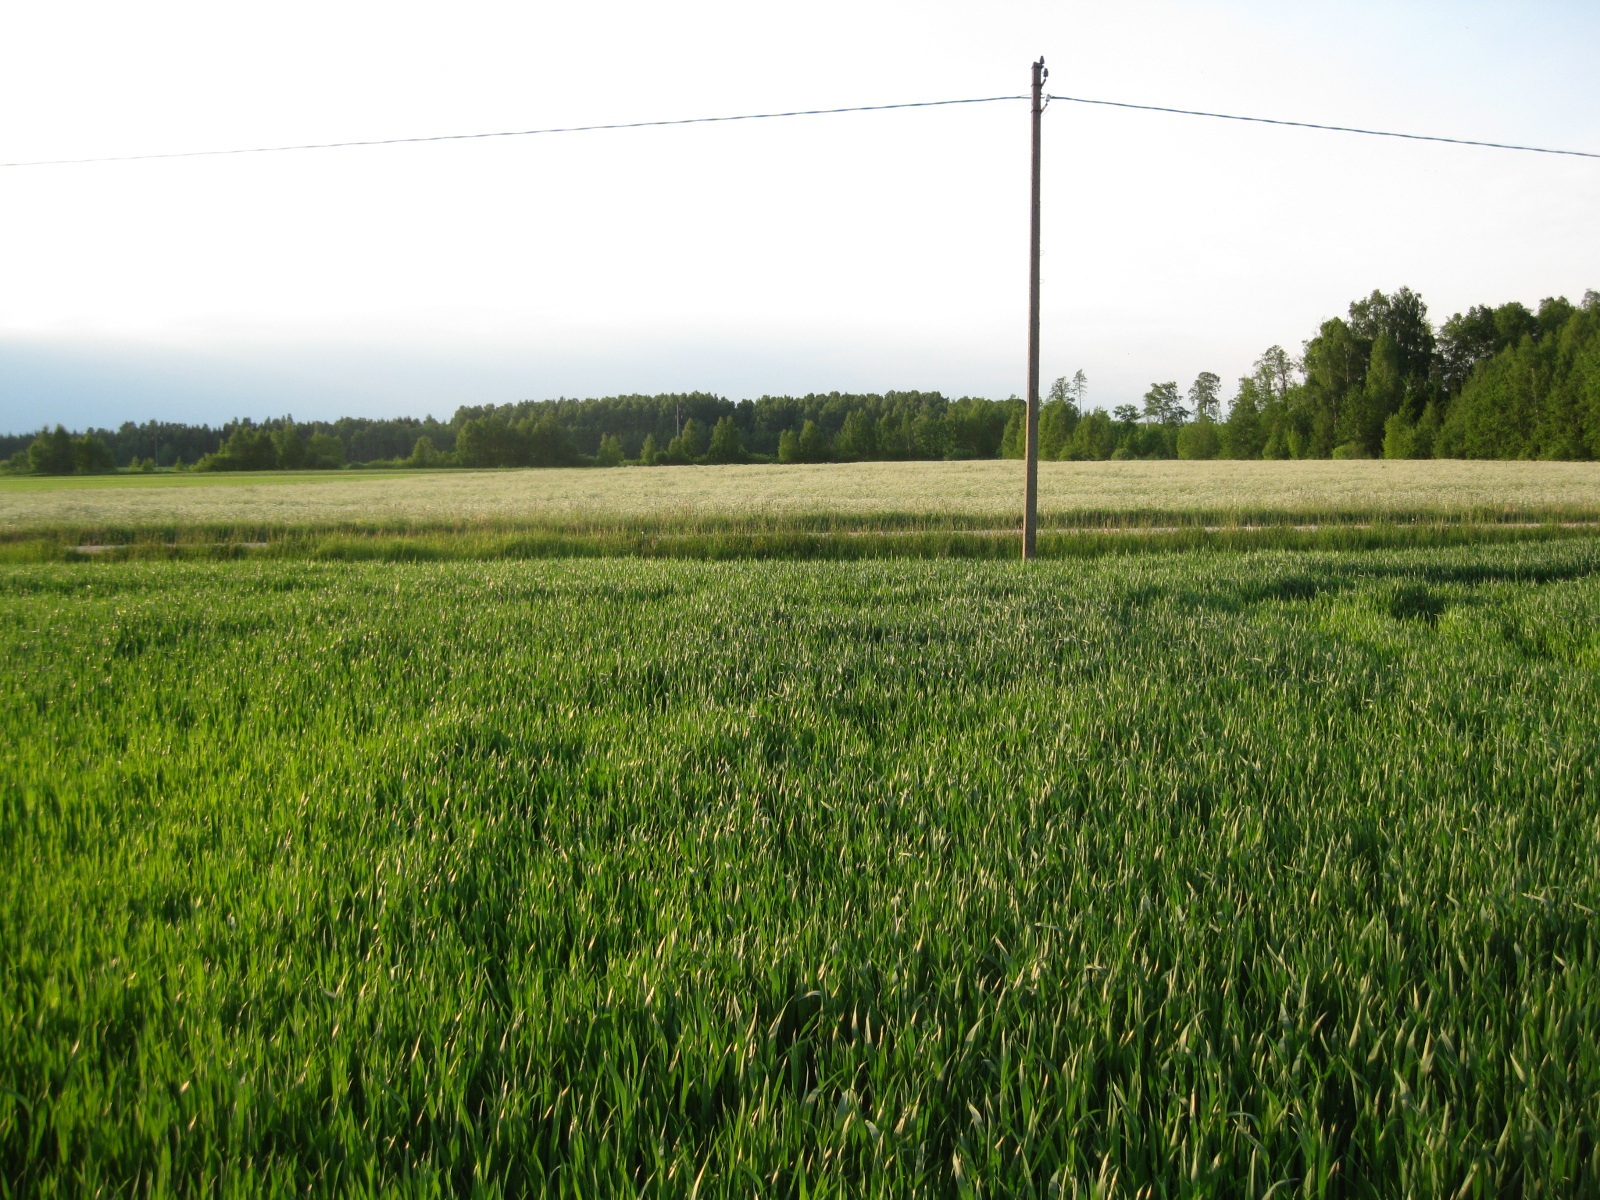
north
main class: Cropland
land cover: Common wheat
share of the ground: > 75 %
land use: Agriculture (excluding fallow land and kitchen gardens)
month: June
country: LT
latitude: 55.8466
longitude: 24.0642
